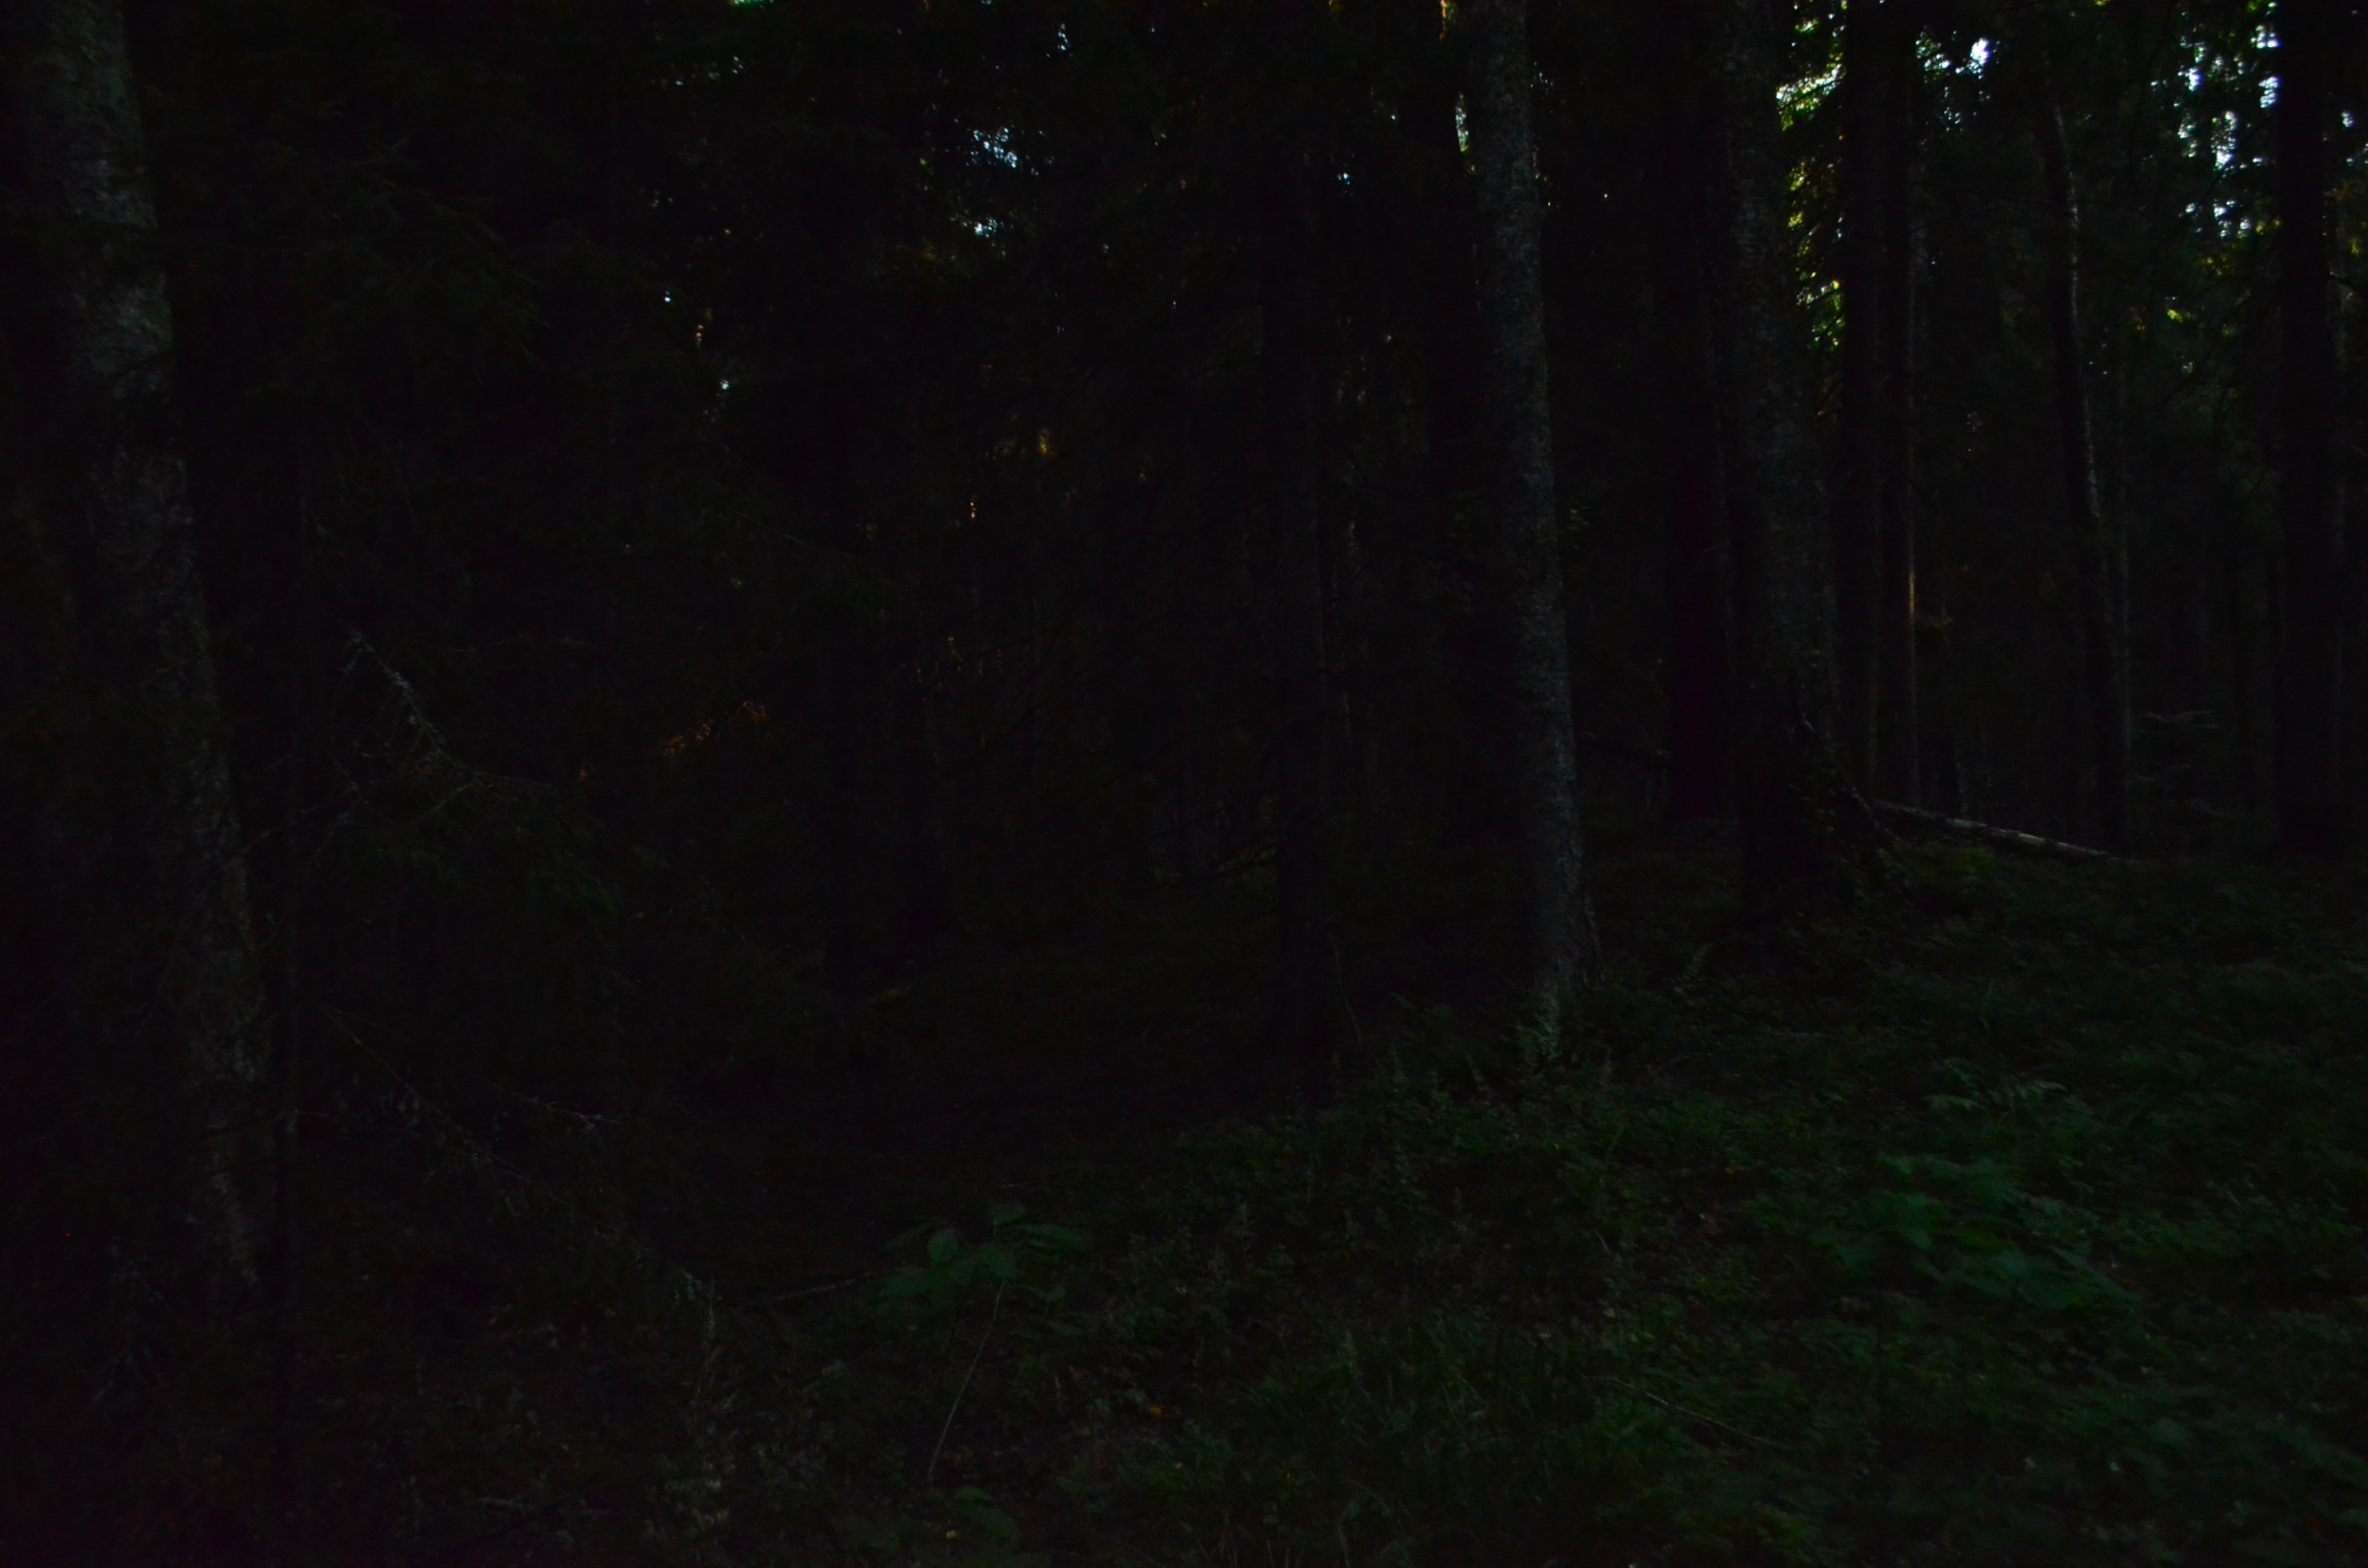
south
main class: Woodland
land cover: Other mixed woodland
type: hemiboreal forest and nemoral coniferous forest and mixed broadleaved-coniferous forest
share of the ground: > 75 %
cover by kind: coniferous forest trees 40 %, broadleaved forest trees 40 %, shrubs 10 %, herbaceous plants 10 %
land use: Forestry
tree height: > 5 m
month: August
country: LV
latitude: 57.5085
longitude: 21.6740
